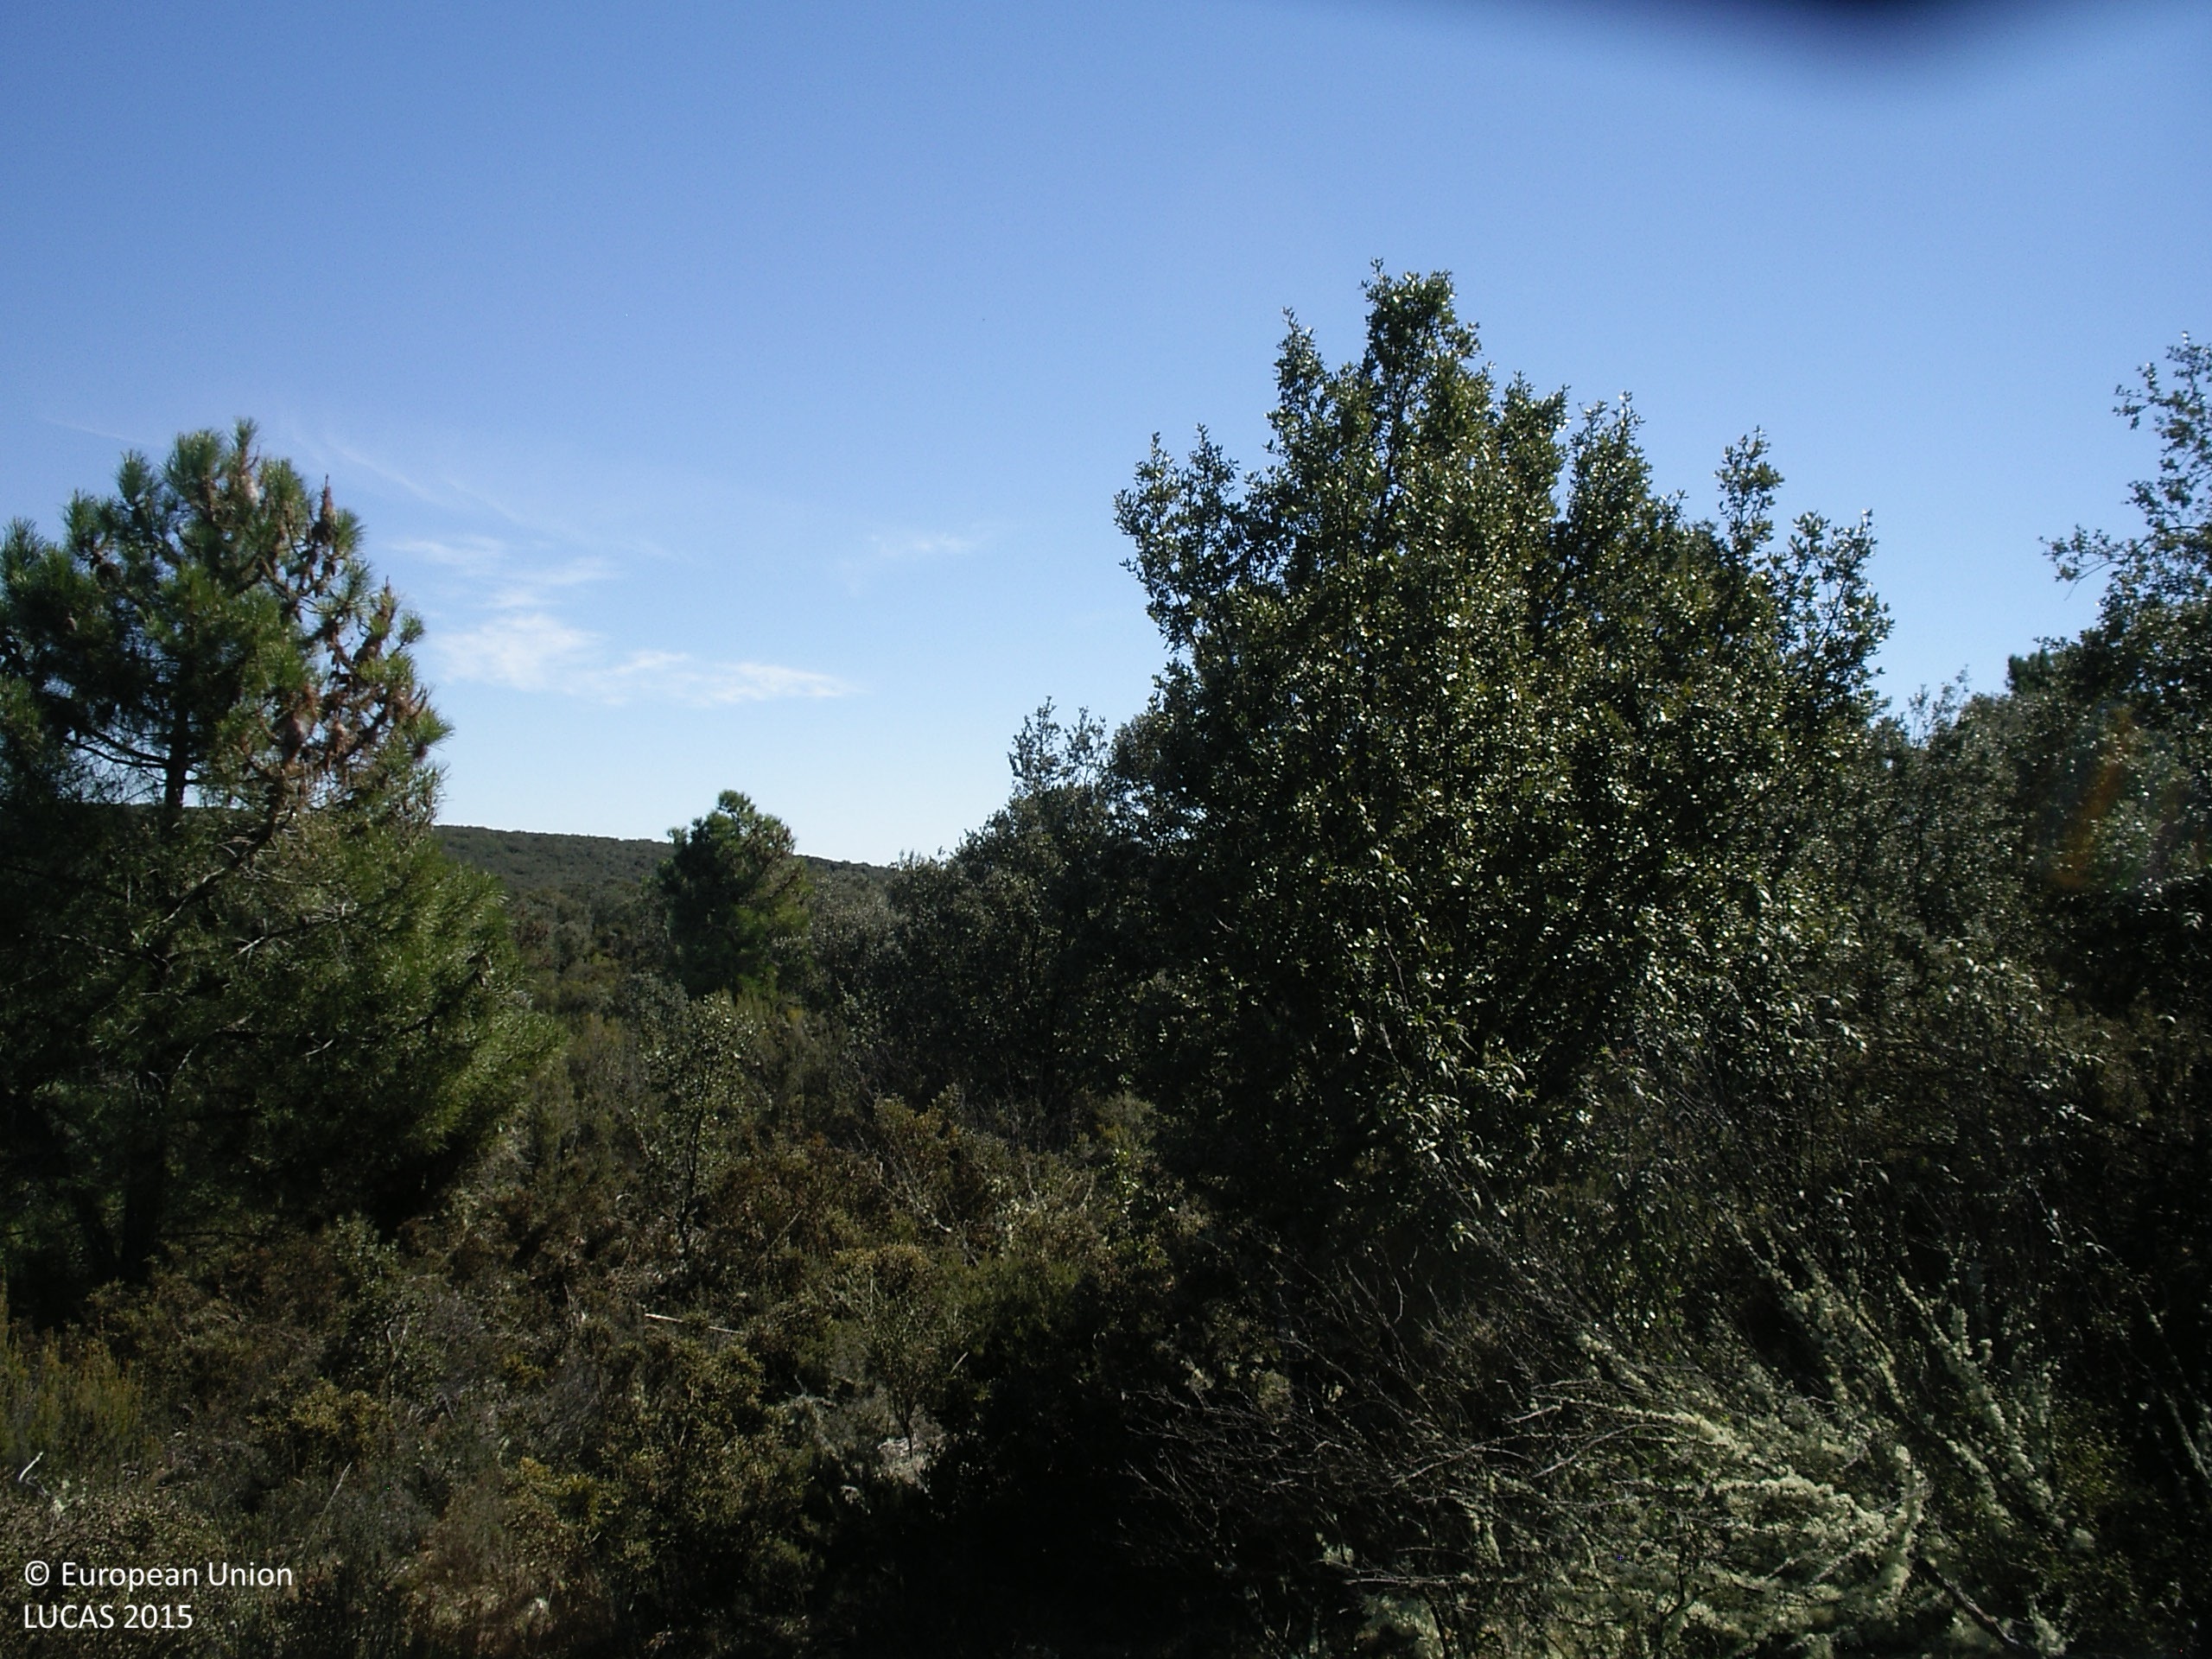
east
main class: Woodland
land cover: Broadleaved woodland
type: broadleaved evergreen forest
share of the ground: > 75 %
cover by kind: broadleaved forest trees 90 %, shrubs 10 %
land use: Forestry
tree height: < 5 m
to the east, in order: Broadleaved woodland; Shrubland with sparse tree cover; Broadleaved woodland; Tracks; Broadleaved woodland; Shrubland with sparse tree cover; Broadleaved woodland
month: March
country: ES
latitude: 42.3612
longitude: -6.0216
